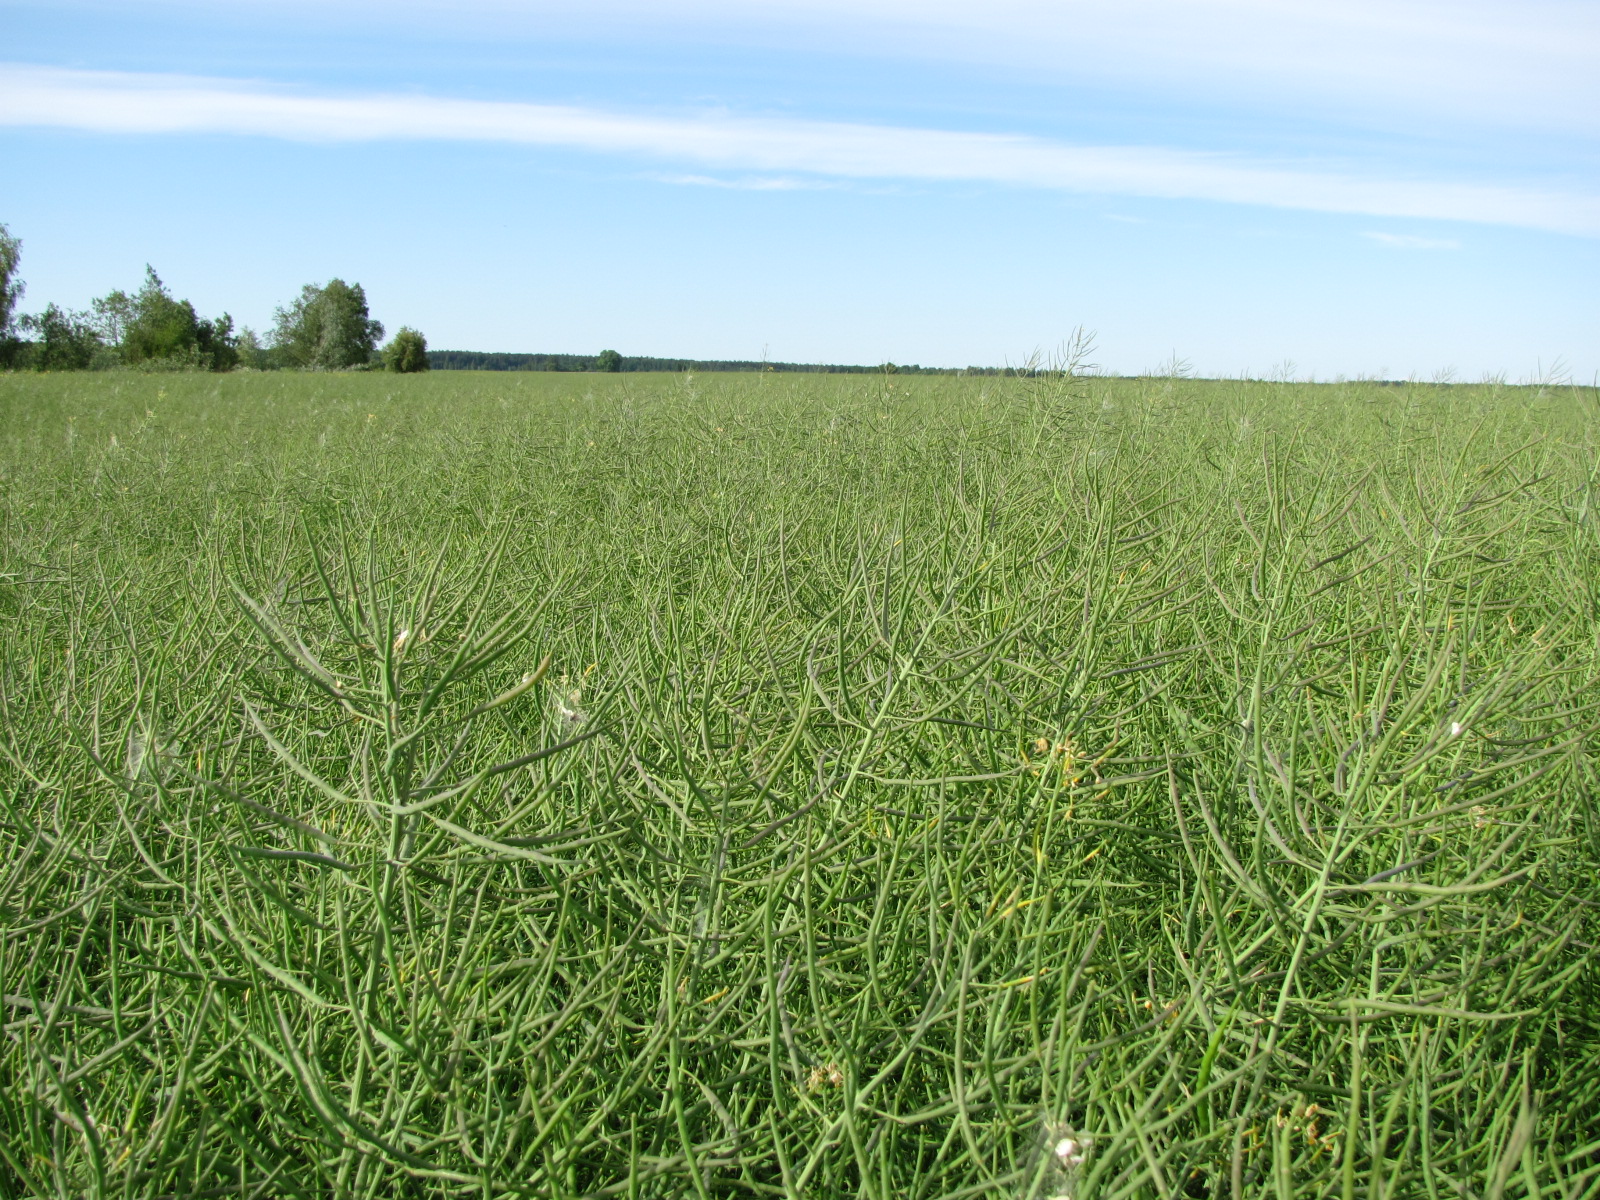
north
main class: Cropland
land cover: Rape and turnip rape
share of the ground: > 75 %
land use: Agriculture (excluding fallow land and kitchen gardens)
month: June
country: LV
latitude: 56.5667
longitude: 23.8329
